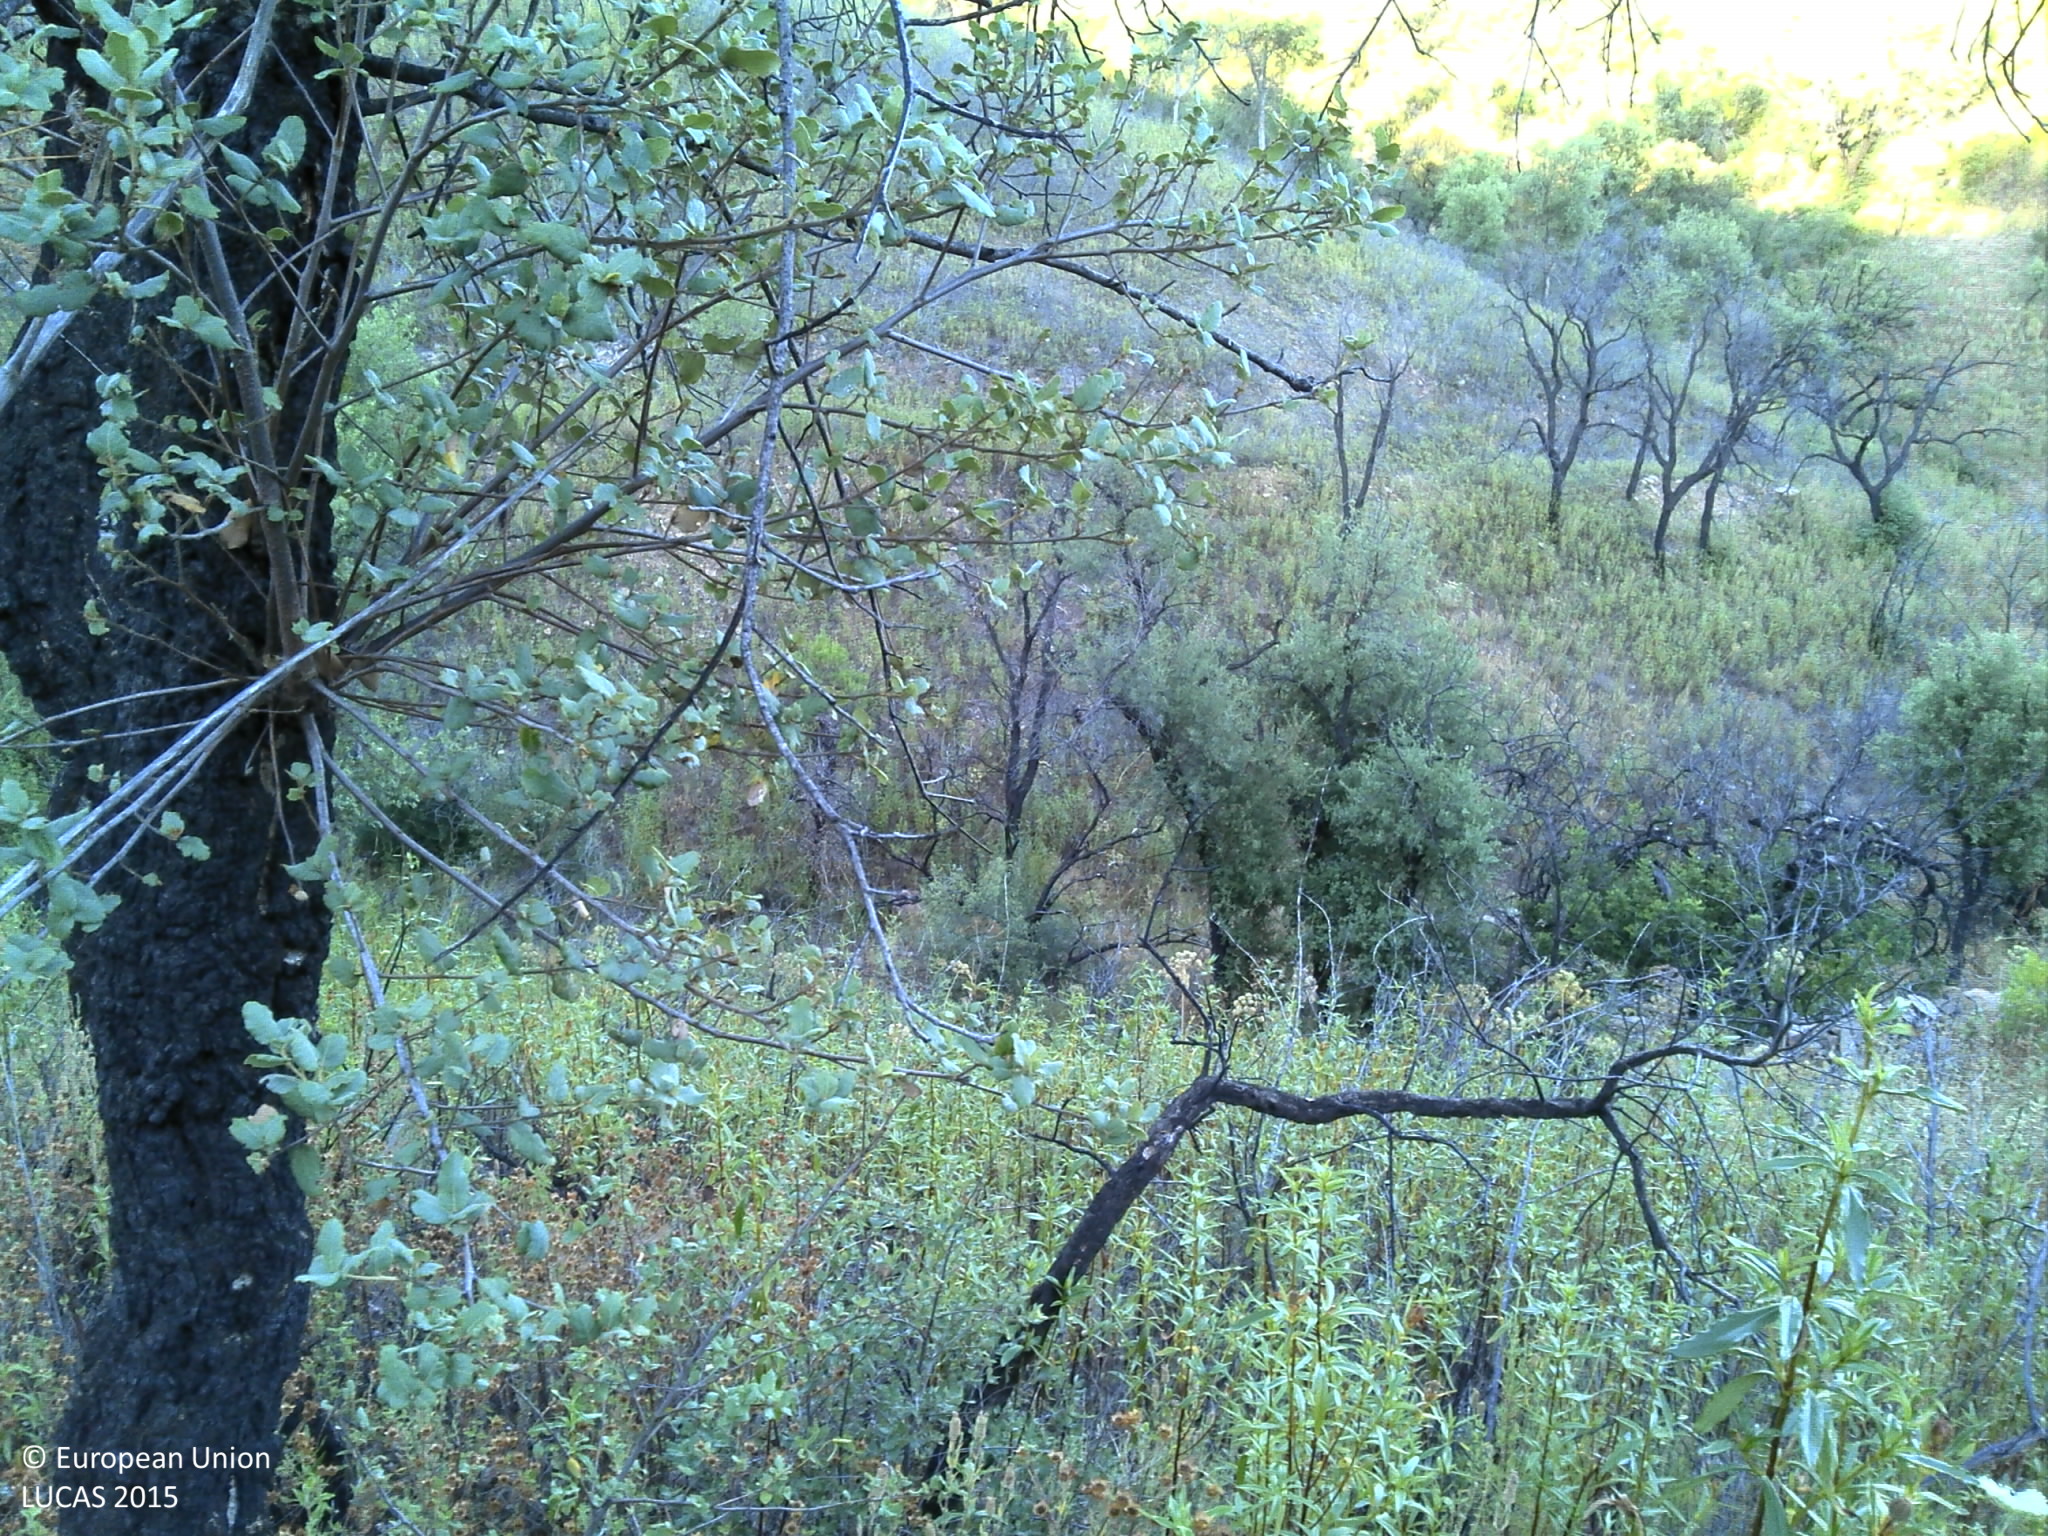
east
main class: Shrubland
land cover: Shrubland with sparse tree cover
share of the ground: > 75 %
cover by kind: shrubs 95 %, broadleaved forest trees 5 %
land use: Abandoned areas
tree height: < 5 m
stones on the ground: < 10 %
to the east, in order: Shrubland with sparse tree cover; Dry stone walls; Ditches and canals; Shrubland with sparse tree cover; Electric lines; Shrubland without tree cover; Broadleaved woodland; Rivers and streams; Broadleaved woodland; Dry stone walls; Grassland without tree/shrub cover; Tracks; Grassland without tree/shrub cover; Dry stone walls; Abandoned hedges; Grass margins; Paved roads, cycling and walking lanes; Grass margins; Broadleaved woodland
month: June
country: PT
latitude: 37.2674
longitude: -7.8402
